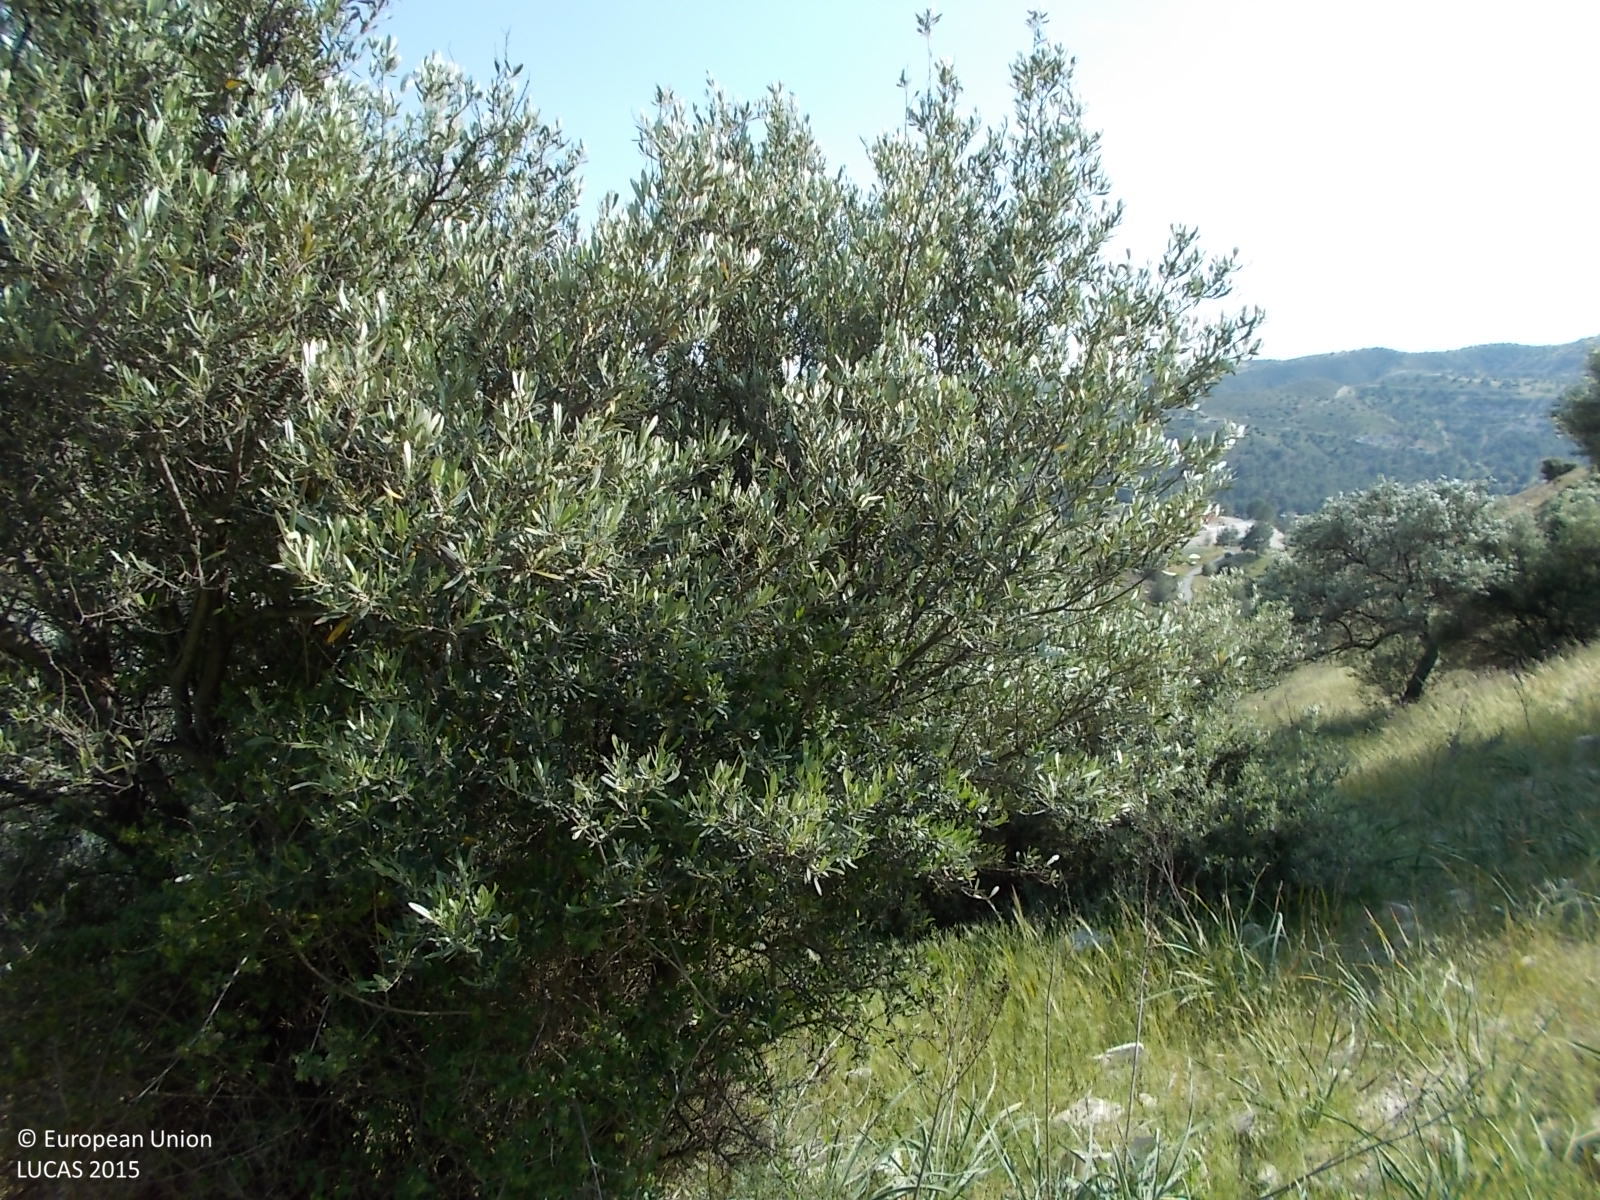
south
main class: Cropland
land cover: Olive groves
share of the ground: 25 - 50 %
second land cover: Grassland without tree/shrub cover
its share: > 75 %
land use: Abandoned areas
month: April
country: CY
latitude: 34.9507
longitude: 33.4826
